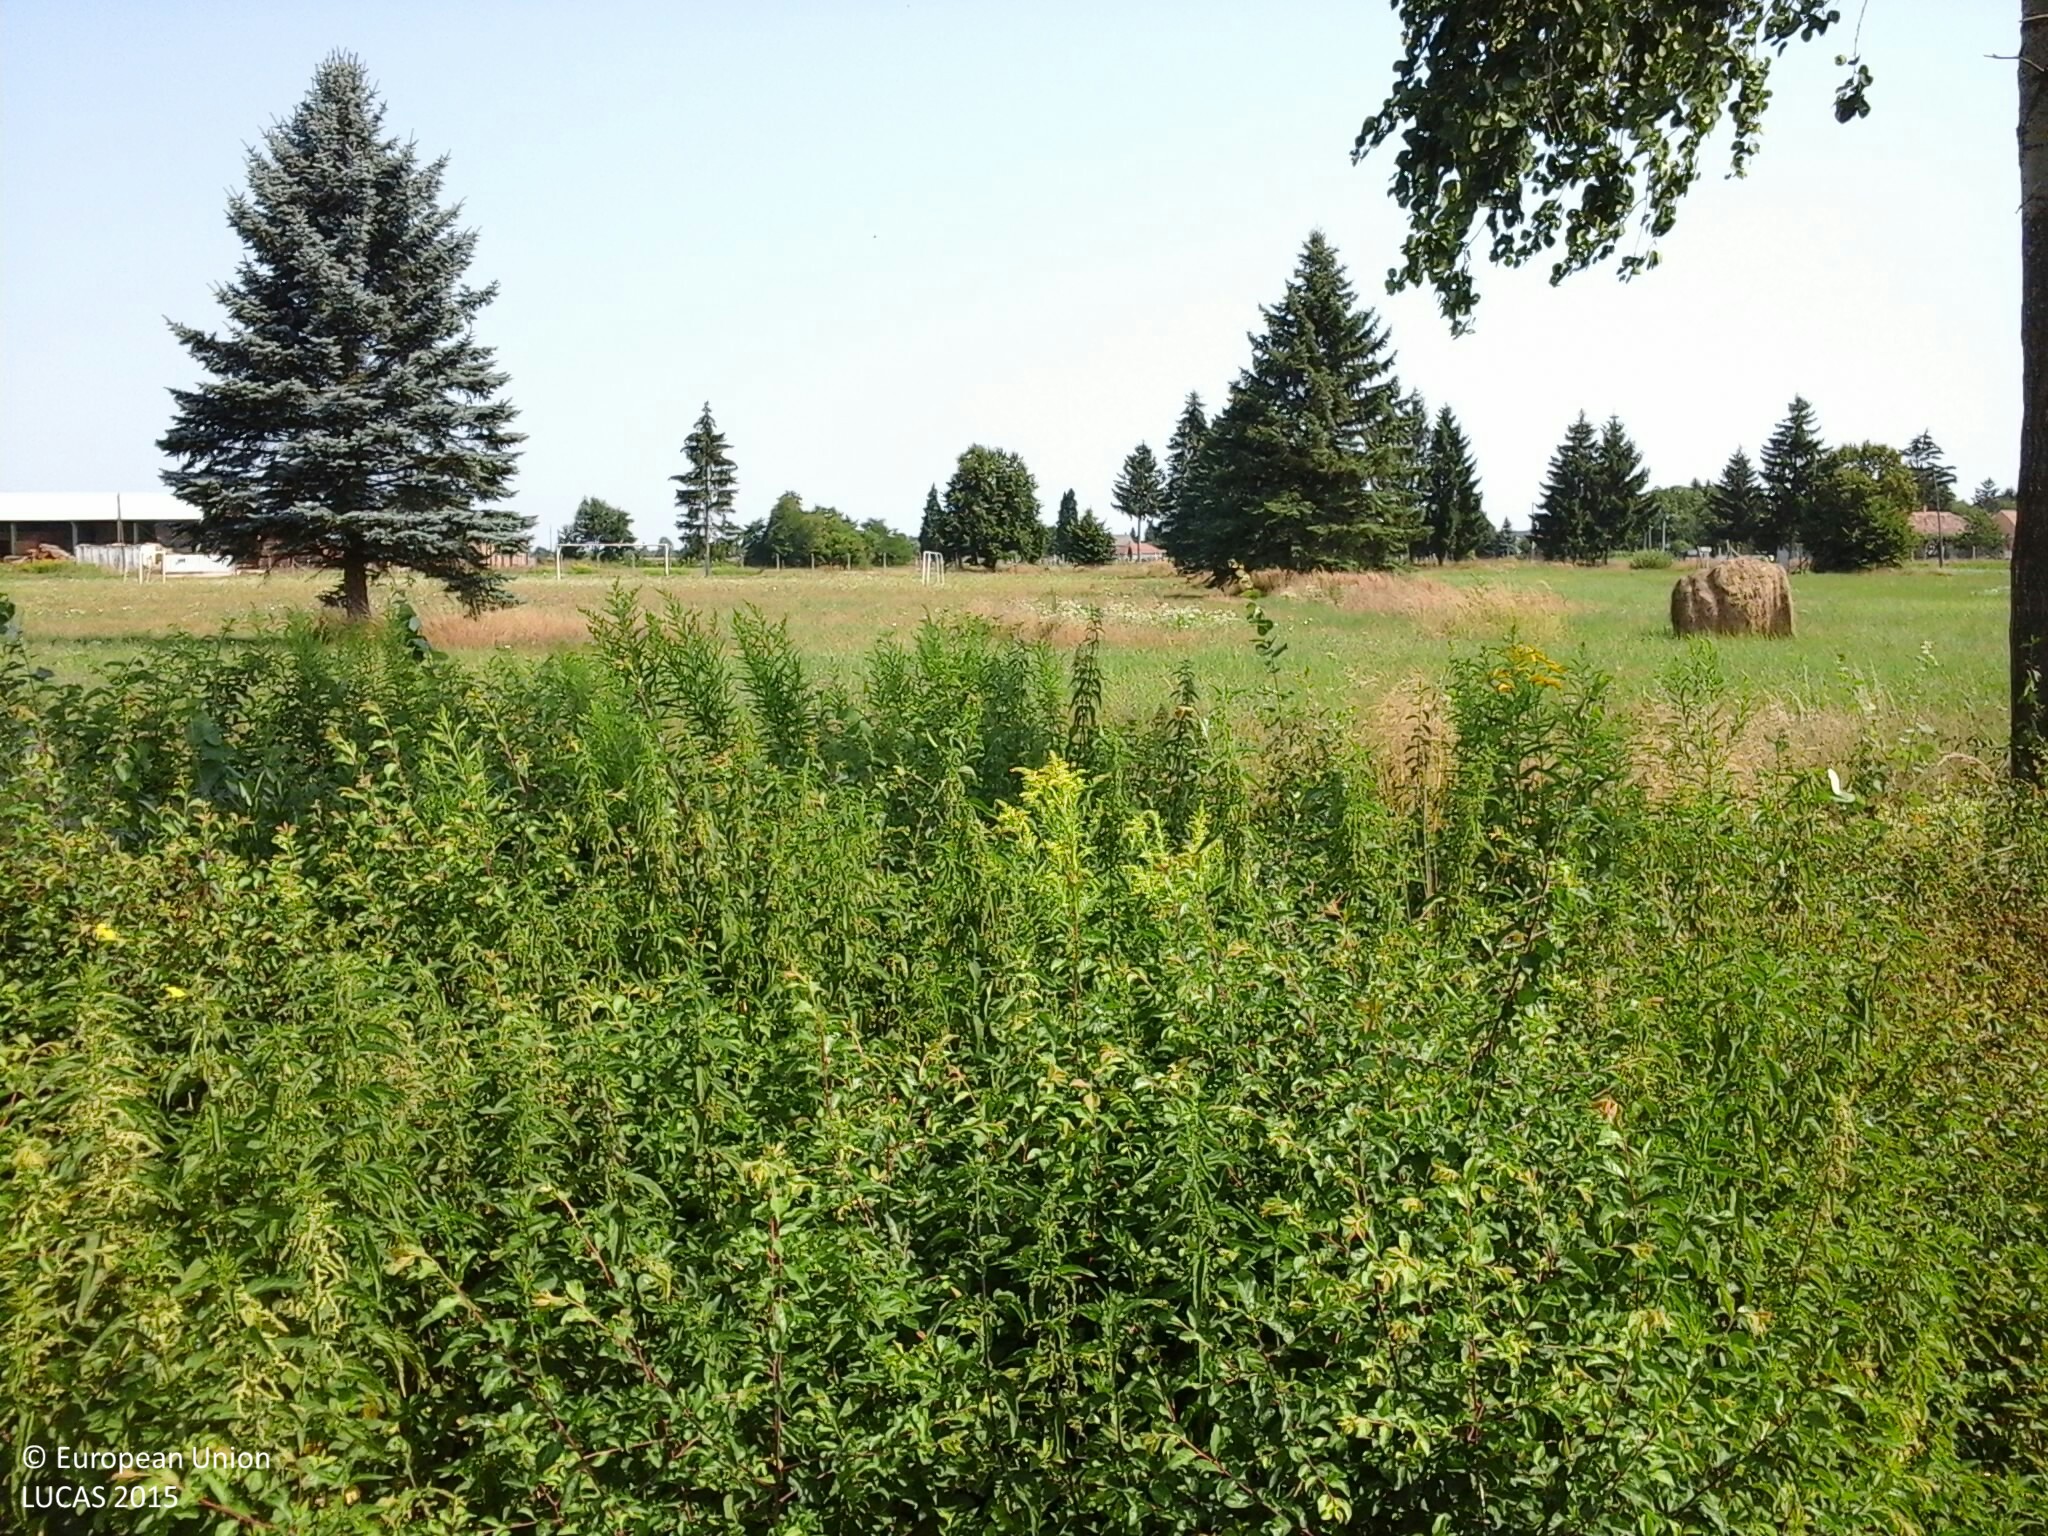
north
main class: Cropland
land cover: Maize
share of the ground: > 75 %
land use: Agriculture (excluding fallow land and kitchen gardens)
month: July
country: HU
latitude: 46.6743
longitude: 16.5509
